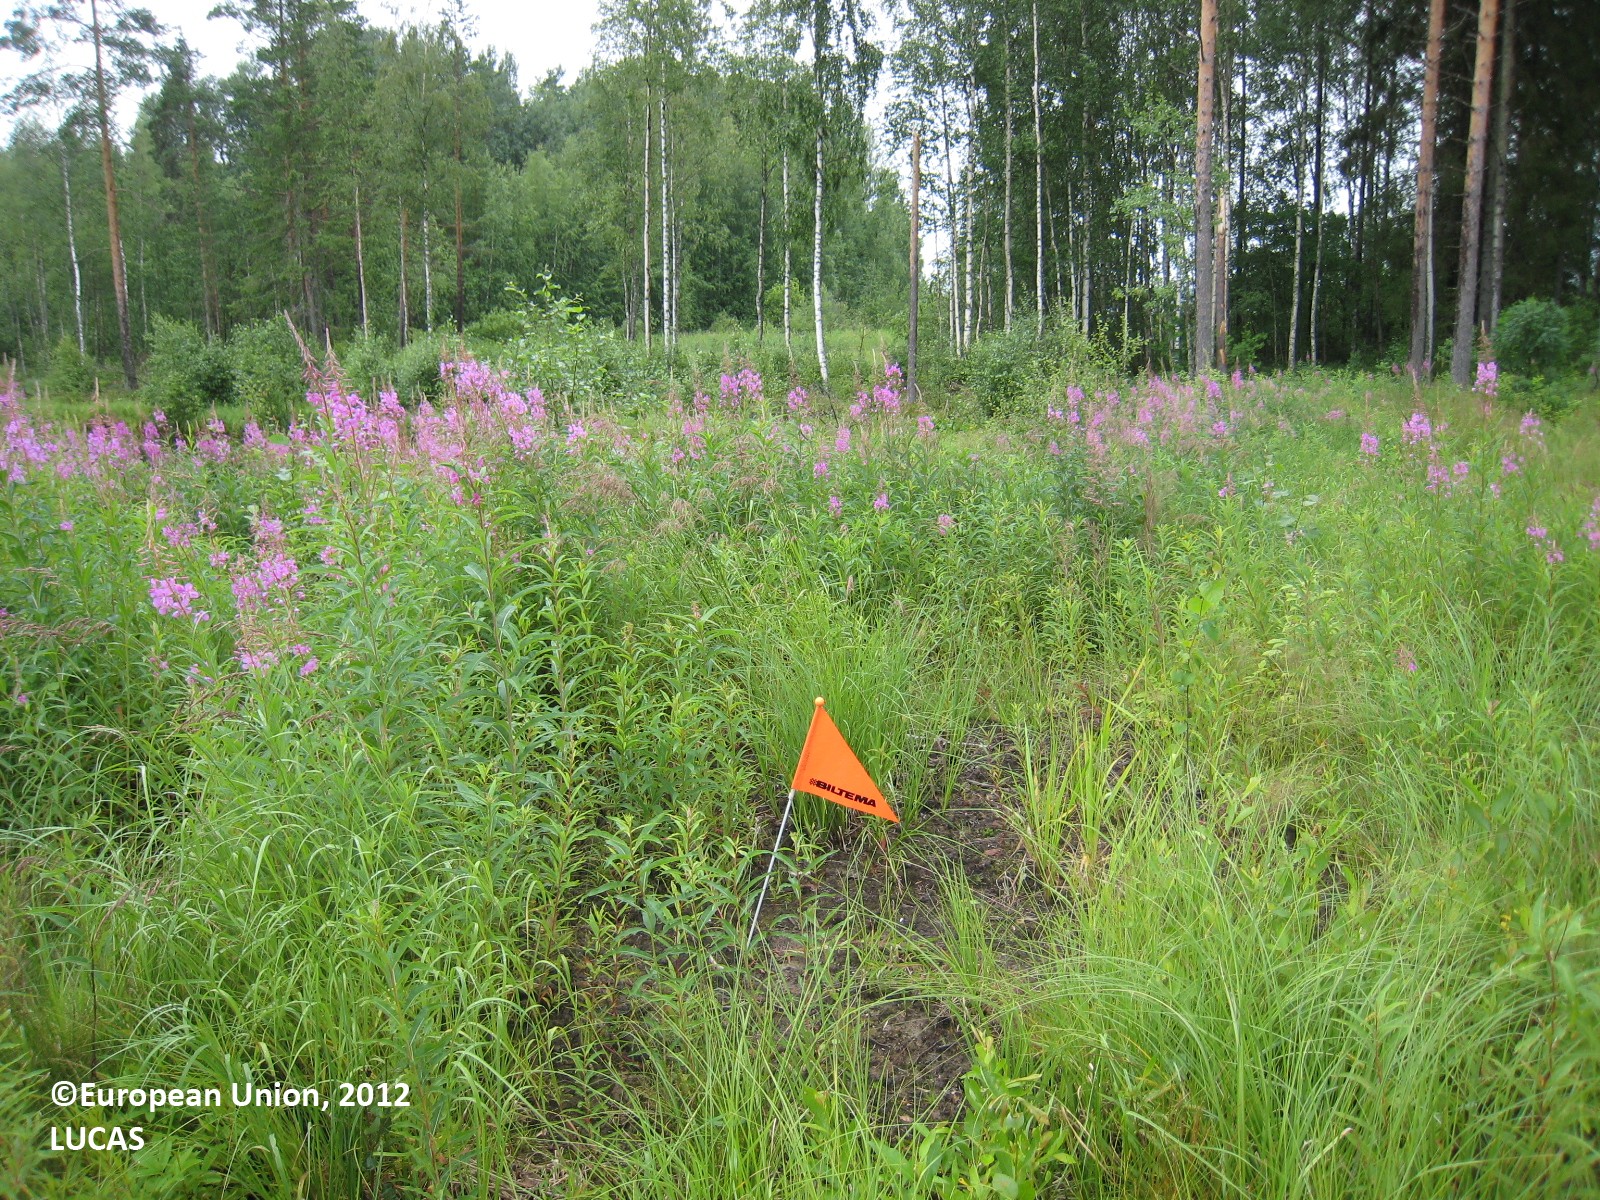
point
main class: Grassland
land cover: Grassland with sparse tree/shrub cover
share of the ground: > 75 %
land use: Amenities, museums, leisure
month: July
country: FI
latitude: 62.9179
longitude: 26.2917
